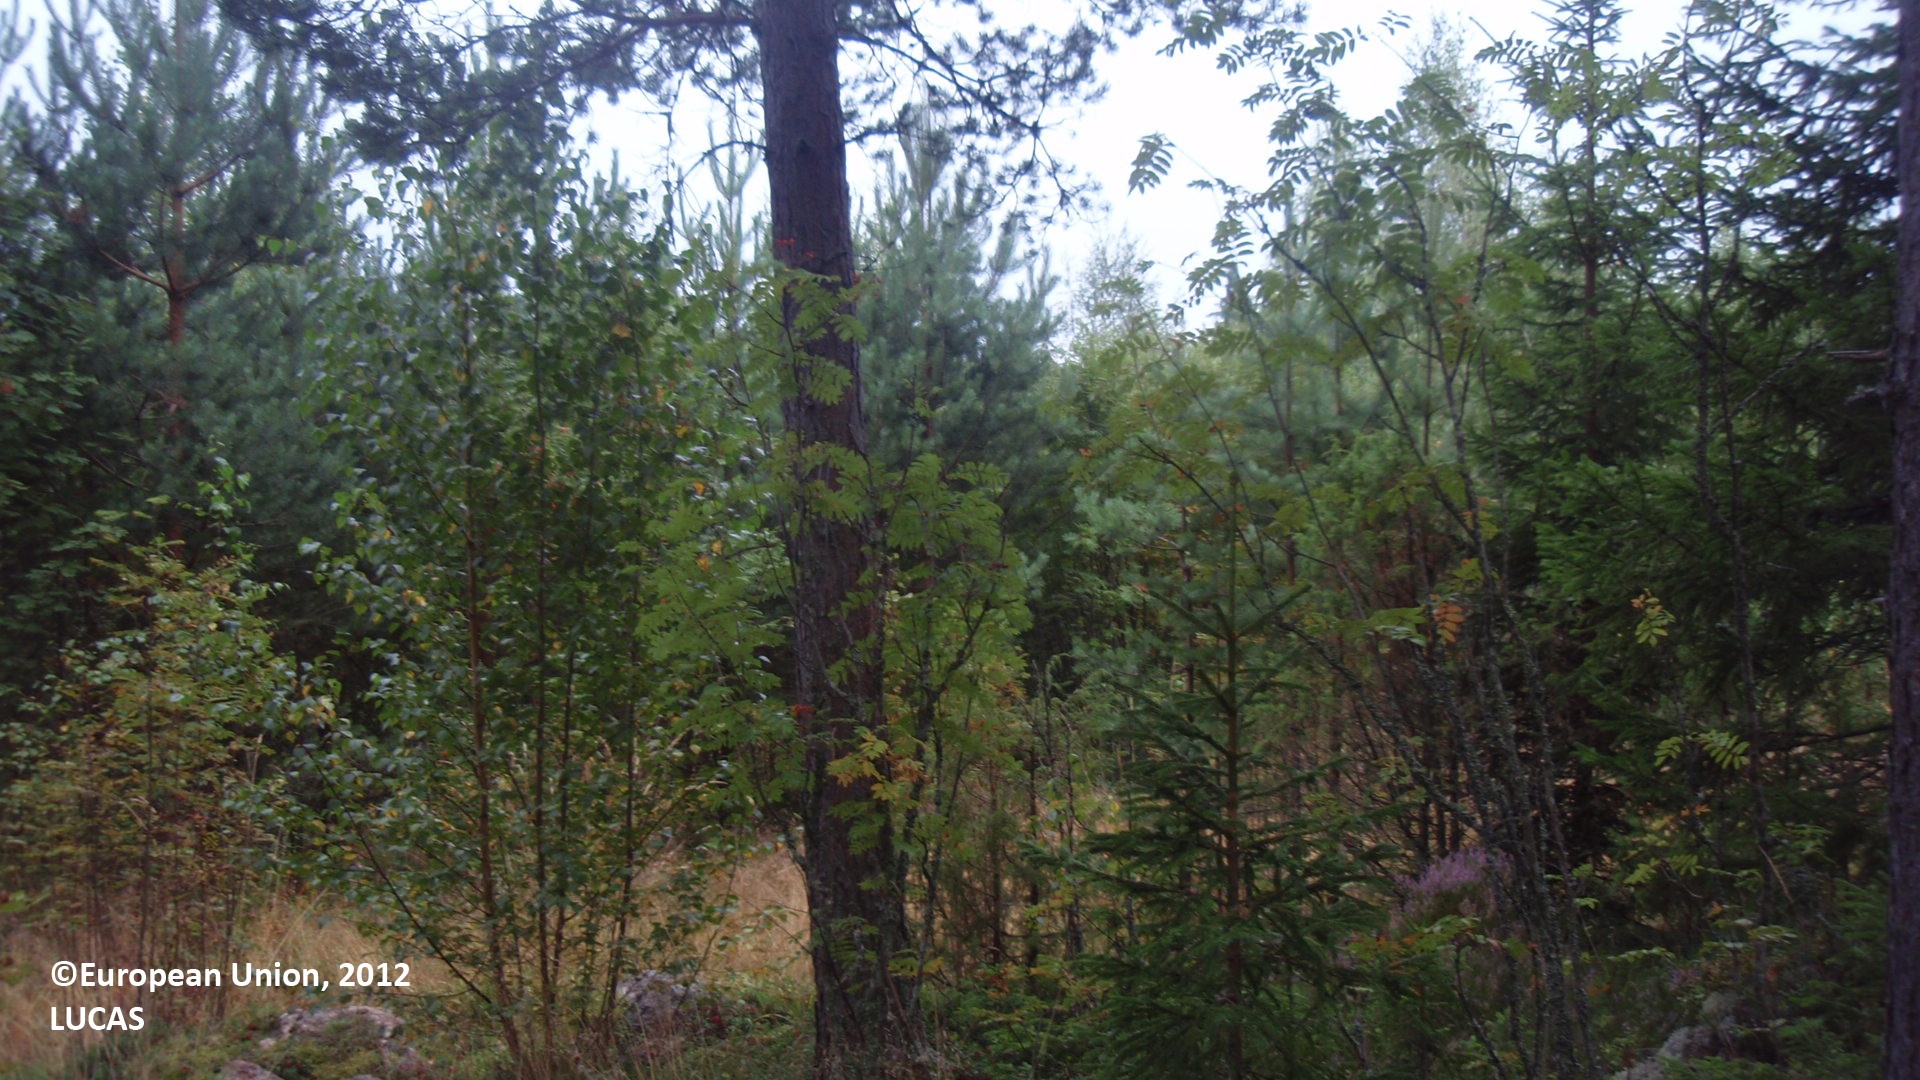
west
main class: Woodland
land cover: Other coniferous woodland
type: boreal forest
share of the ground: 50 - 75 %
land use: Forestry
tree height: > 5 m
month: August
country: FI
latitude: 60.5809
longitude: 26.8281
